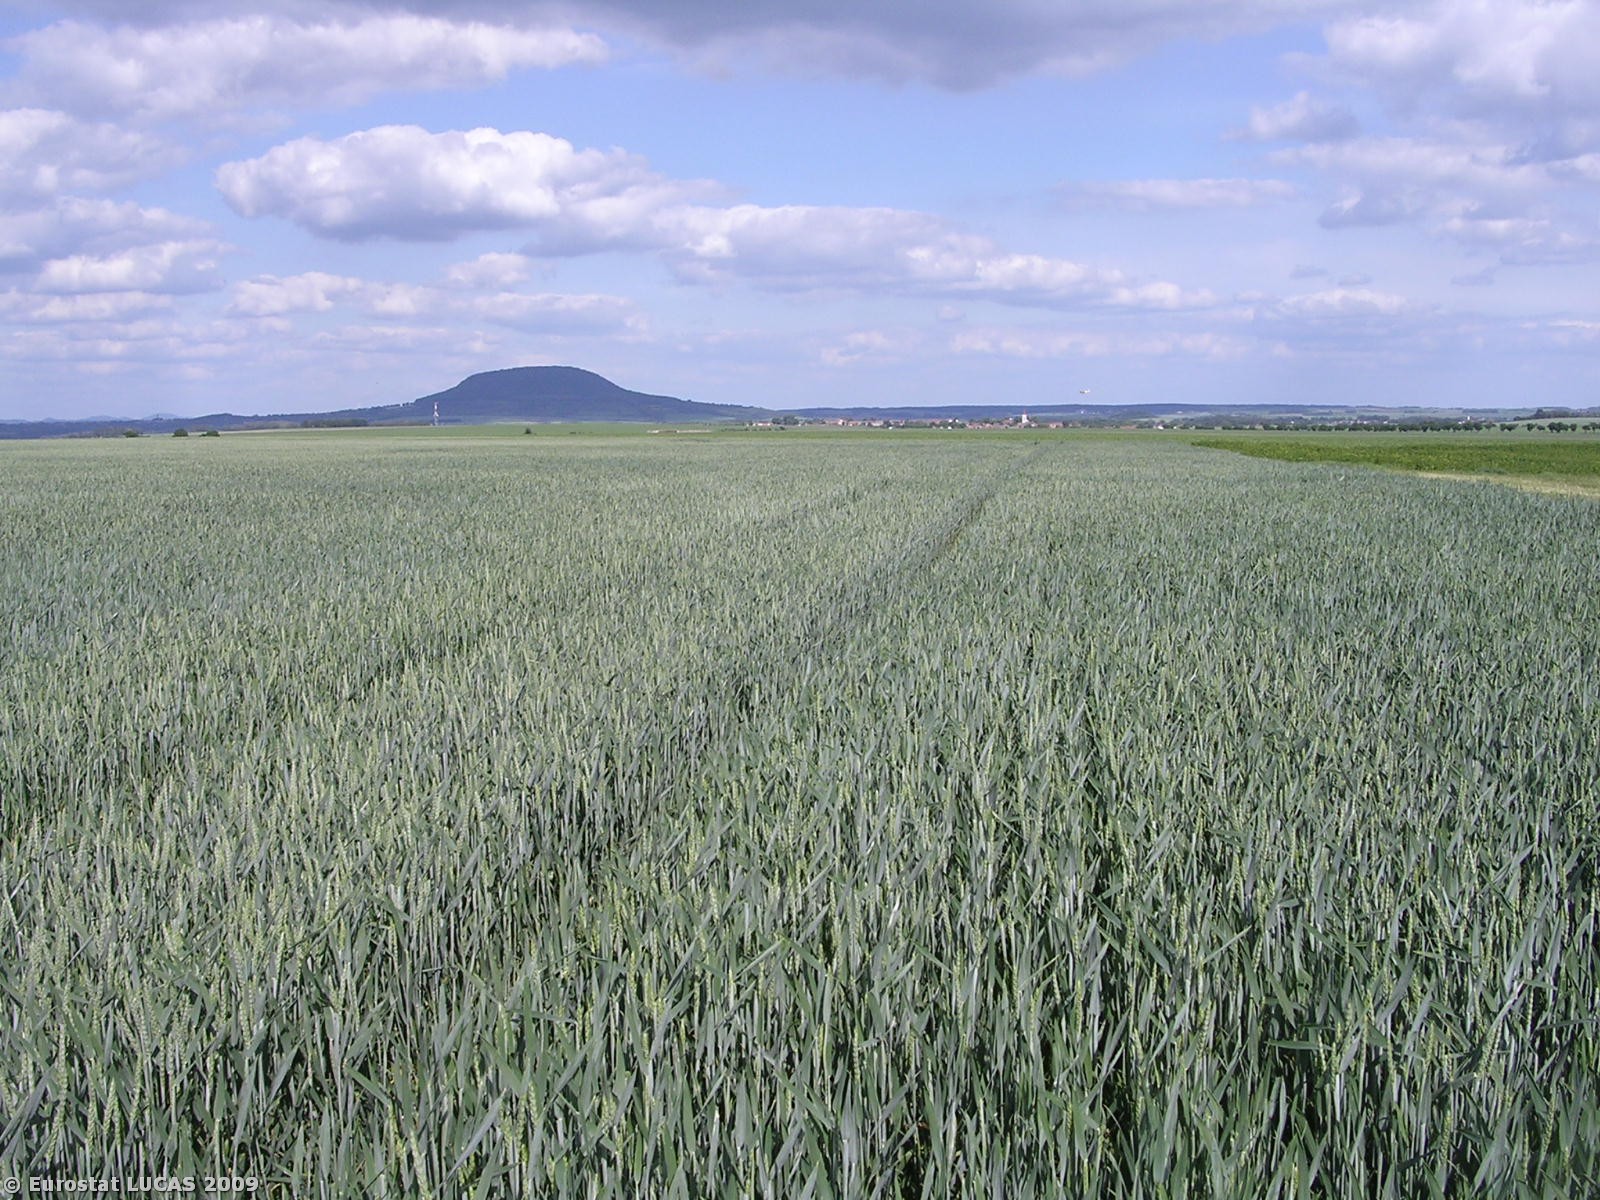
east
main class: Cropland
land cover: Common wheat
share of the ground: > 75 %
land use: Agriculture (excluding fallow land and kitchen gardens)
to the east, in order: Common wheat; Grass margins; Sugar beet
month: May
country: CZ
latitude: 50.3778
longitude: 14.1776
